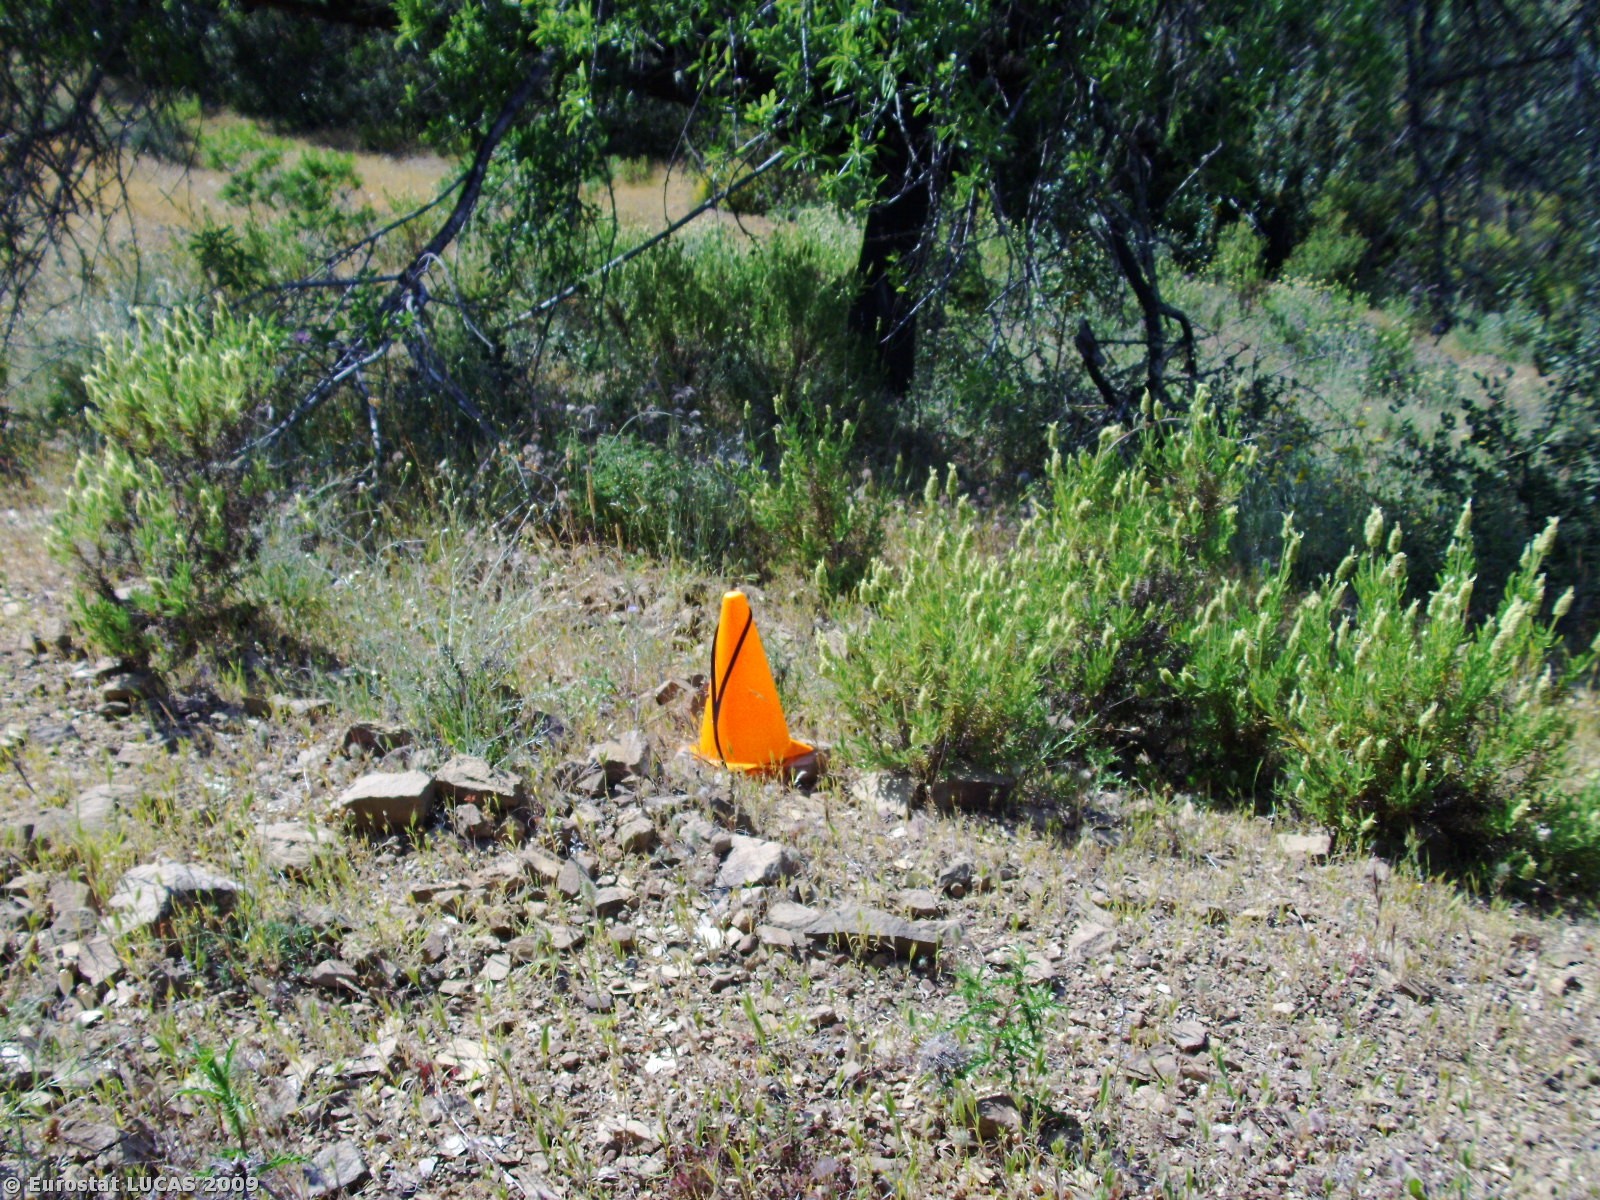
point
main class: Cropland
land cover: Nuts trees
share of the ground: < 10 %
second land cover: Spontaneously vegetated surfaces
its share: > 75 %
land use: Agriculture (excluding fallow land and kitchen gardens)
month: May
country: PT
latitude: 37.3910
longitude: -7.4801
